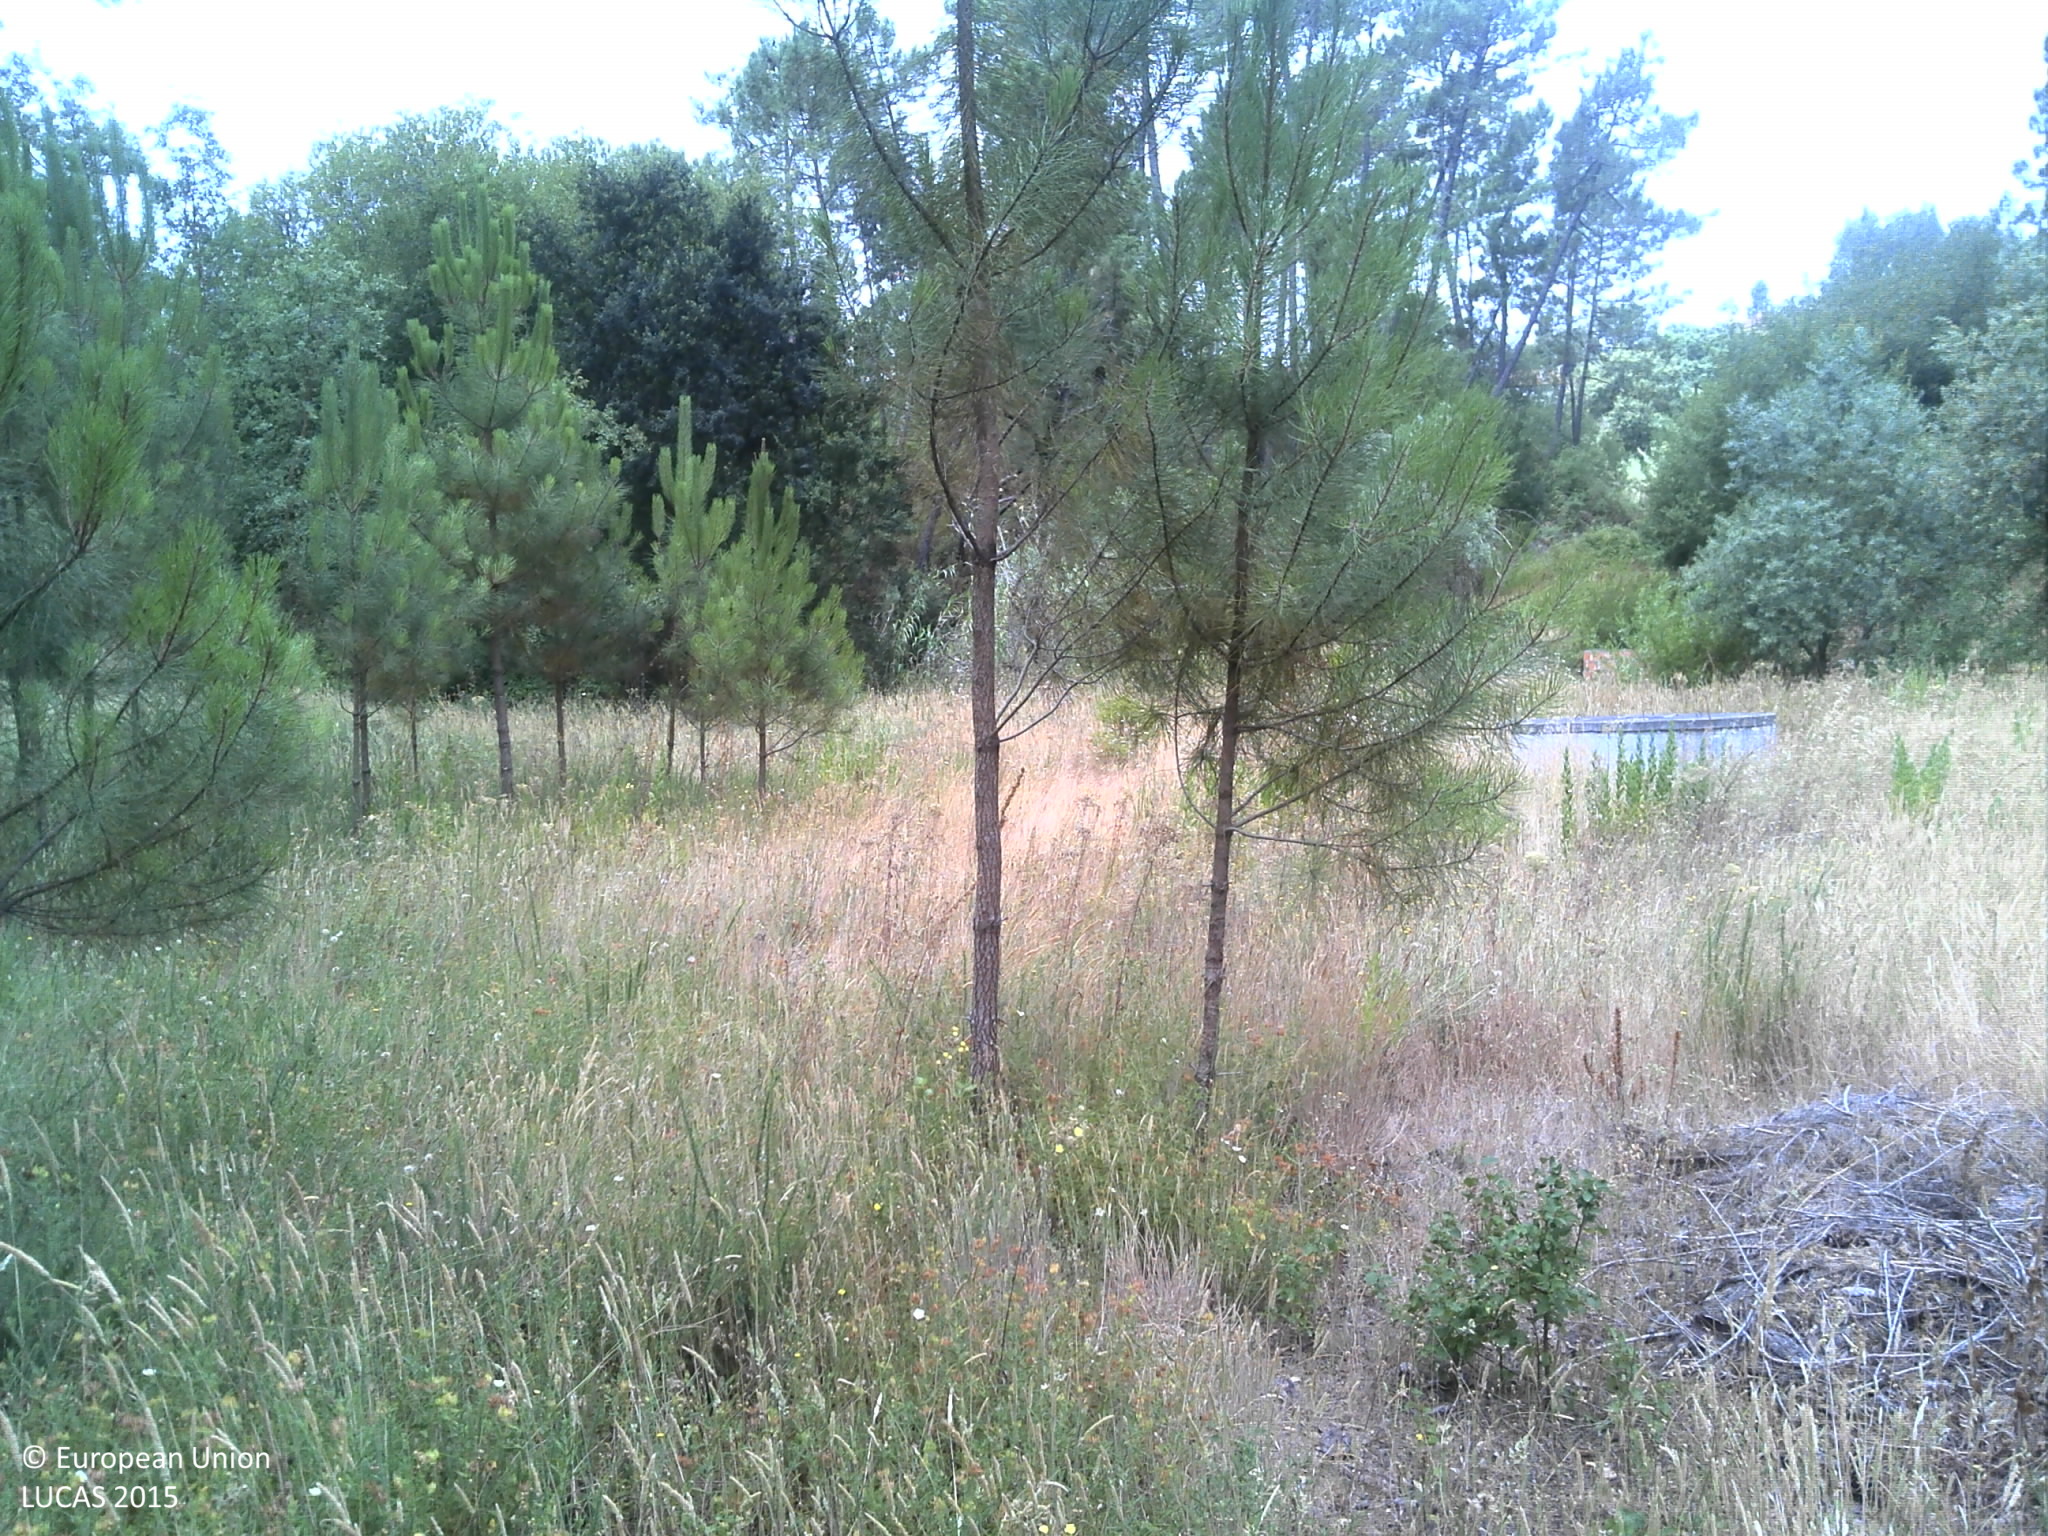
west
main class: Woodland
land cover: Pine dominated coniferous woodland
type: coniferous forest of the mediterranean region
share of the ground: 25 - 50 %
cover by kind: coniferous forest trees 40 %, shrubs 20 %, herbaceous plants 20 %, unconsolidated bare surface 10 %
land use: Forestry
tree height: > 5 m
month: July
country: PT
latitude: 39.8265
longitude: -8.4800
